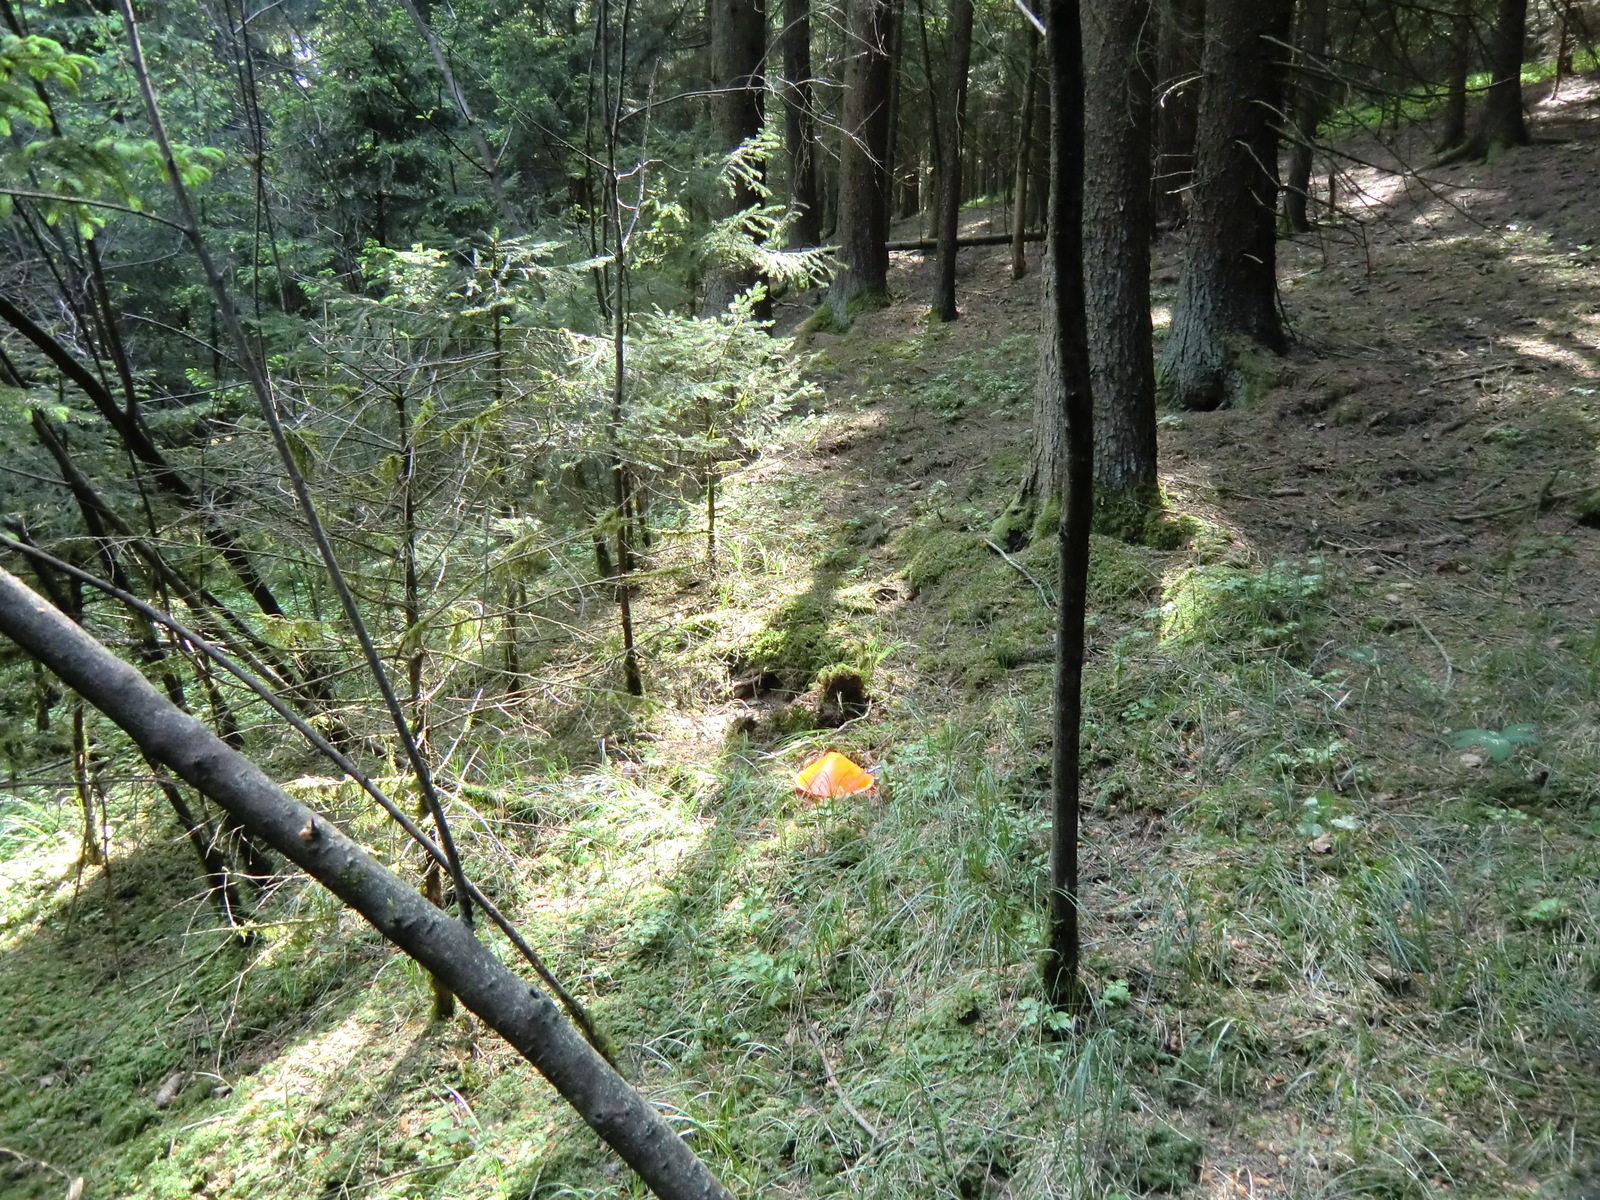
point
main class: Woodland
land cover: Spruce dominated coniferous woodland
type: alpine coniferous forest
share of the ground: > 75 %
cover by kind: coniferous forest trees 70 %, unconsolidated bare surface 30 %
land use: Forestry
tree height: > 5 m
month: May
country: AT
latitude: 48.3335
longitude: 14.4115
